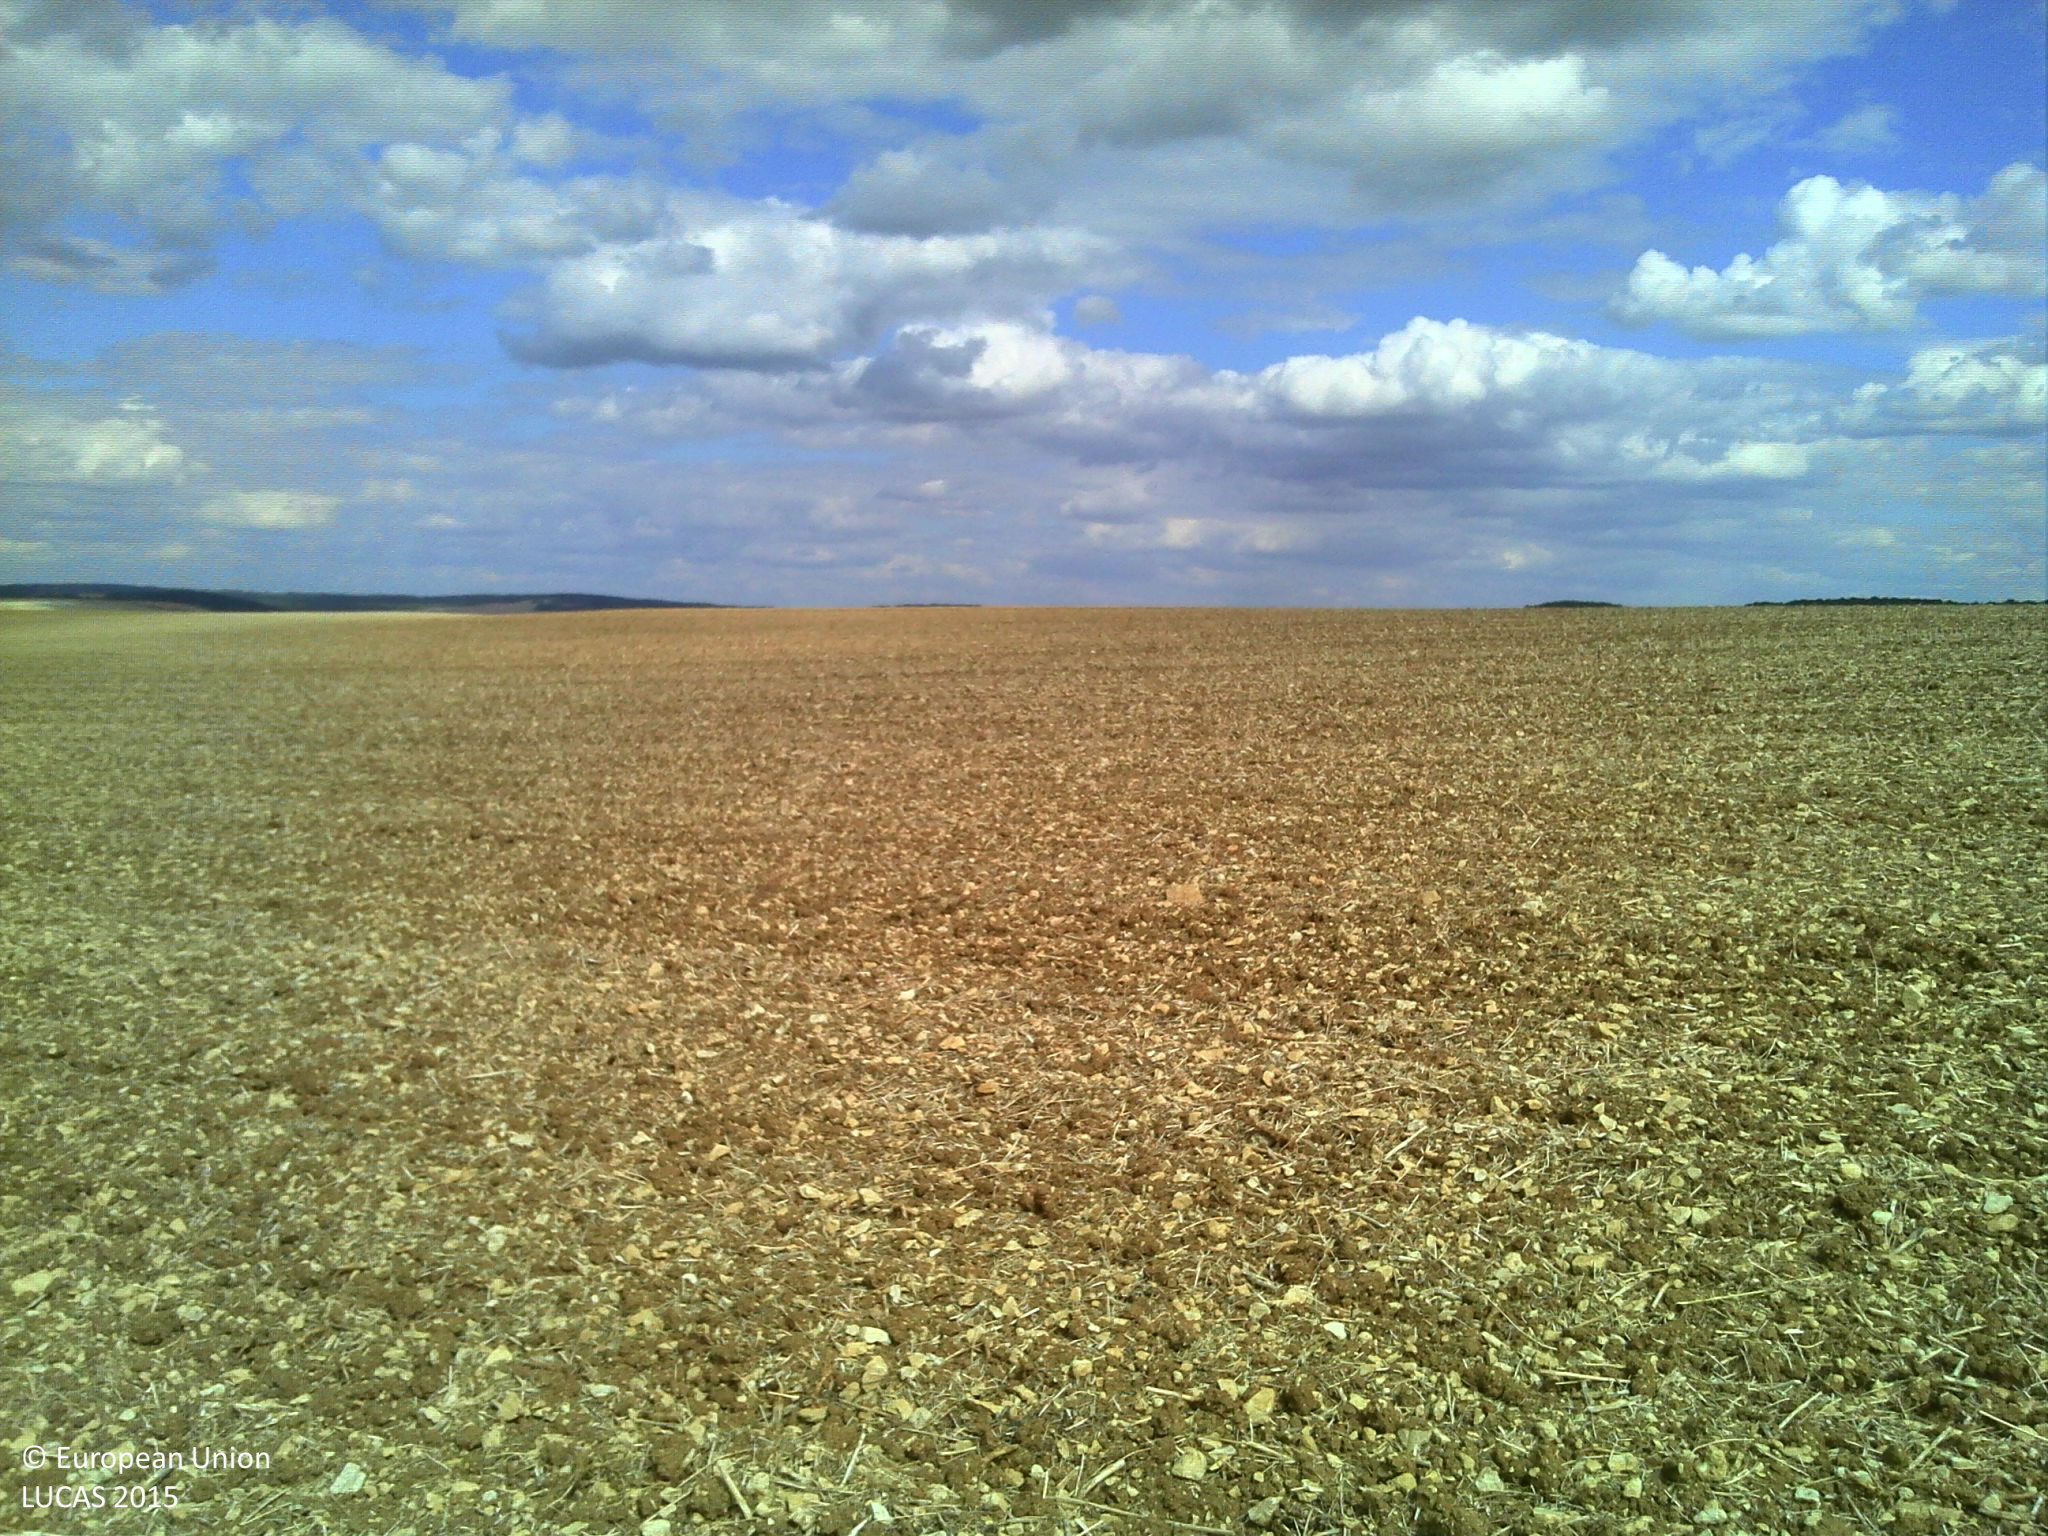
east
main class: Cropland
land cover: Rape and turnip rape
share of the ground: < 10 %
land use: Agriculture (excluding fallow land and kitchen gardens)
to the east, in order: Rape and turnip rape; Other bare soil
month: July
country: FR
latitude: 49.2031
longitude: 5.2632
